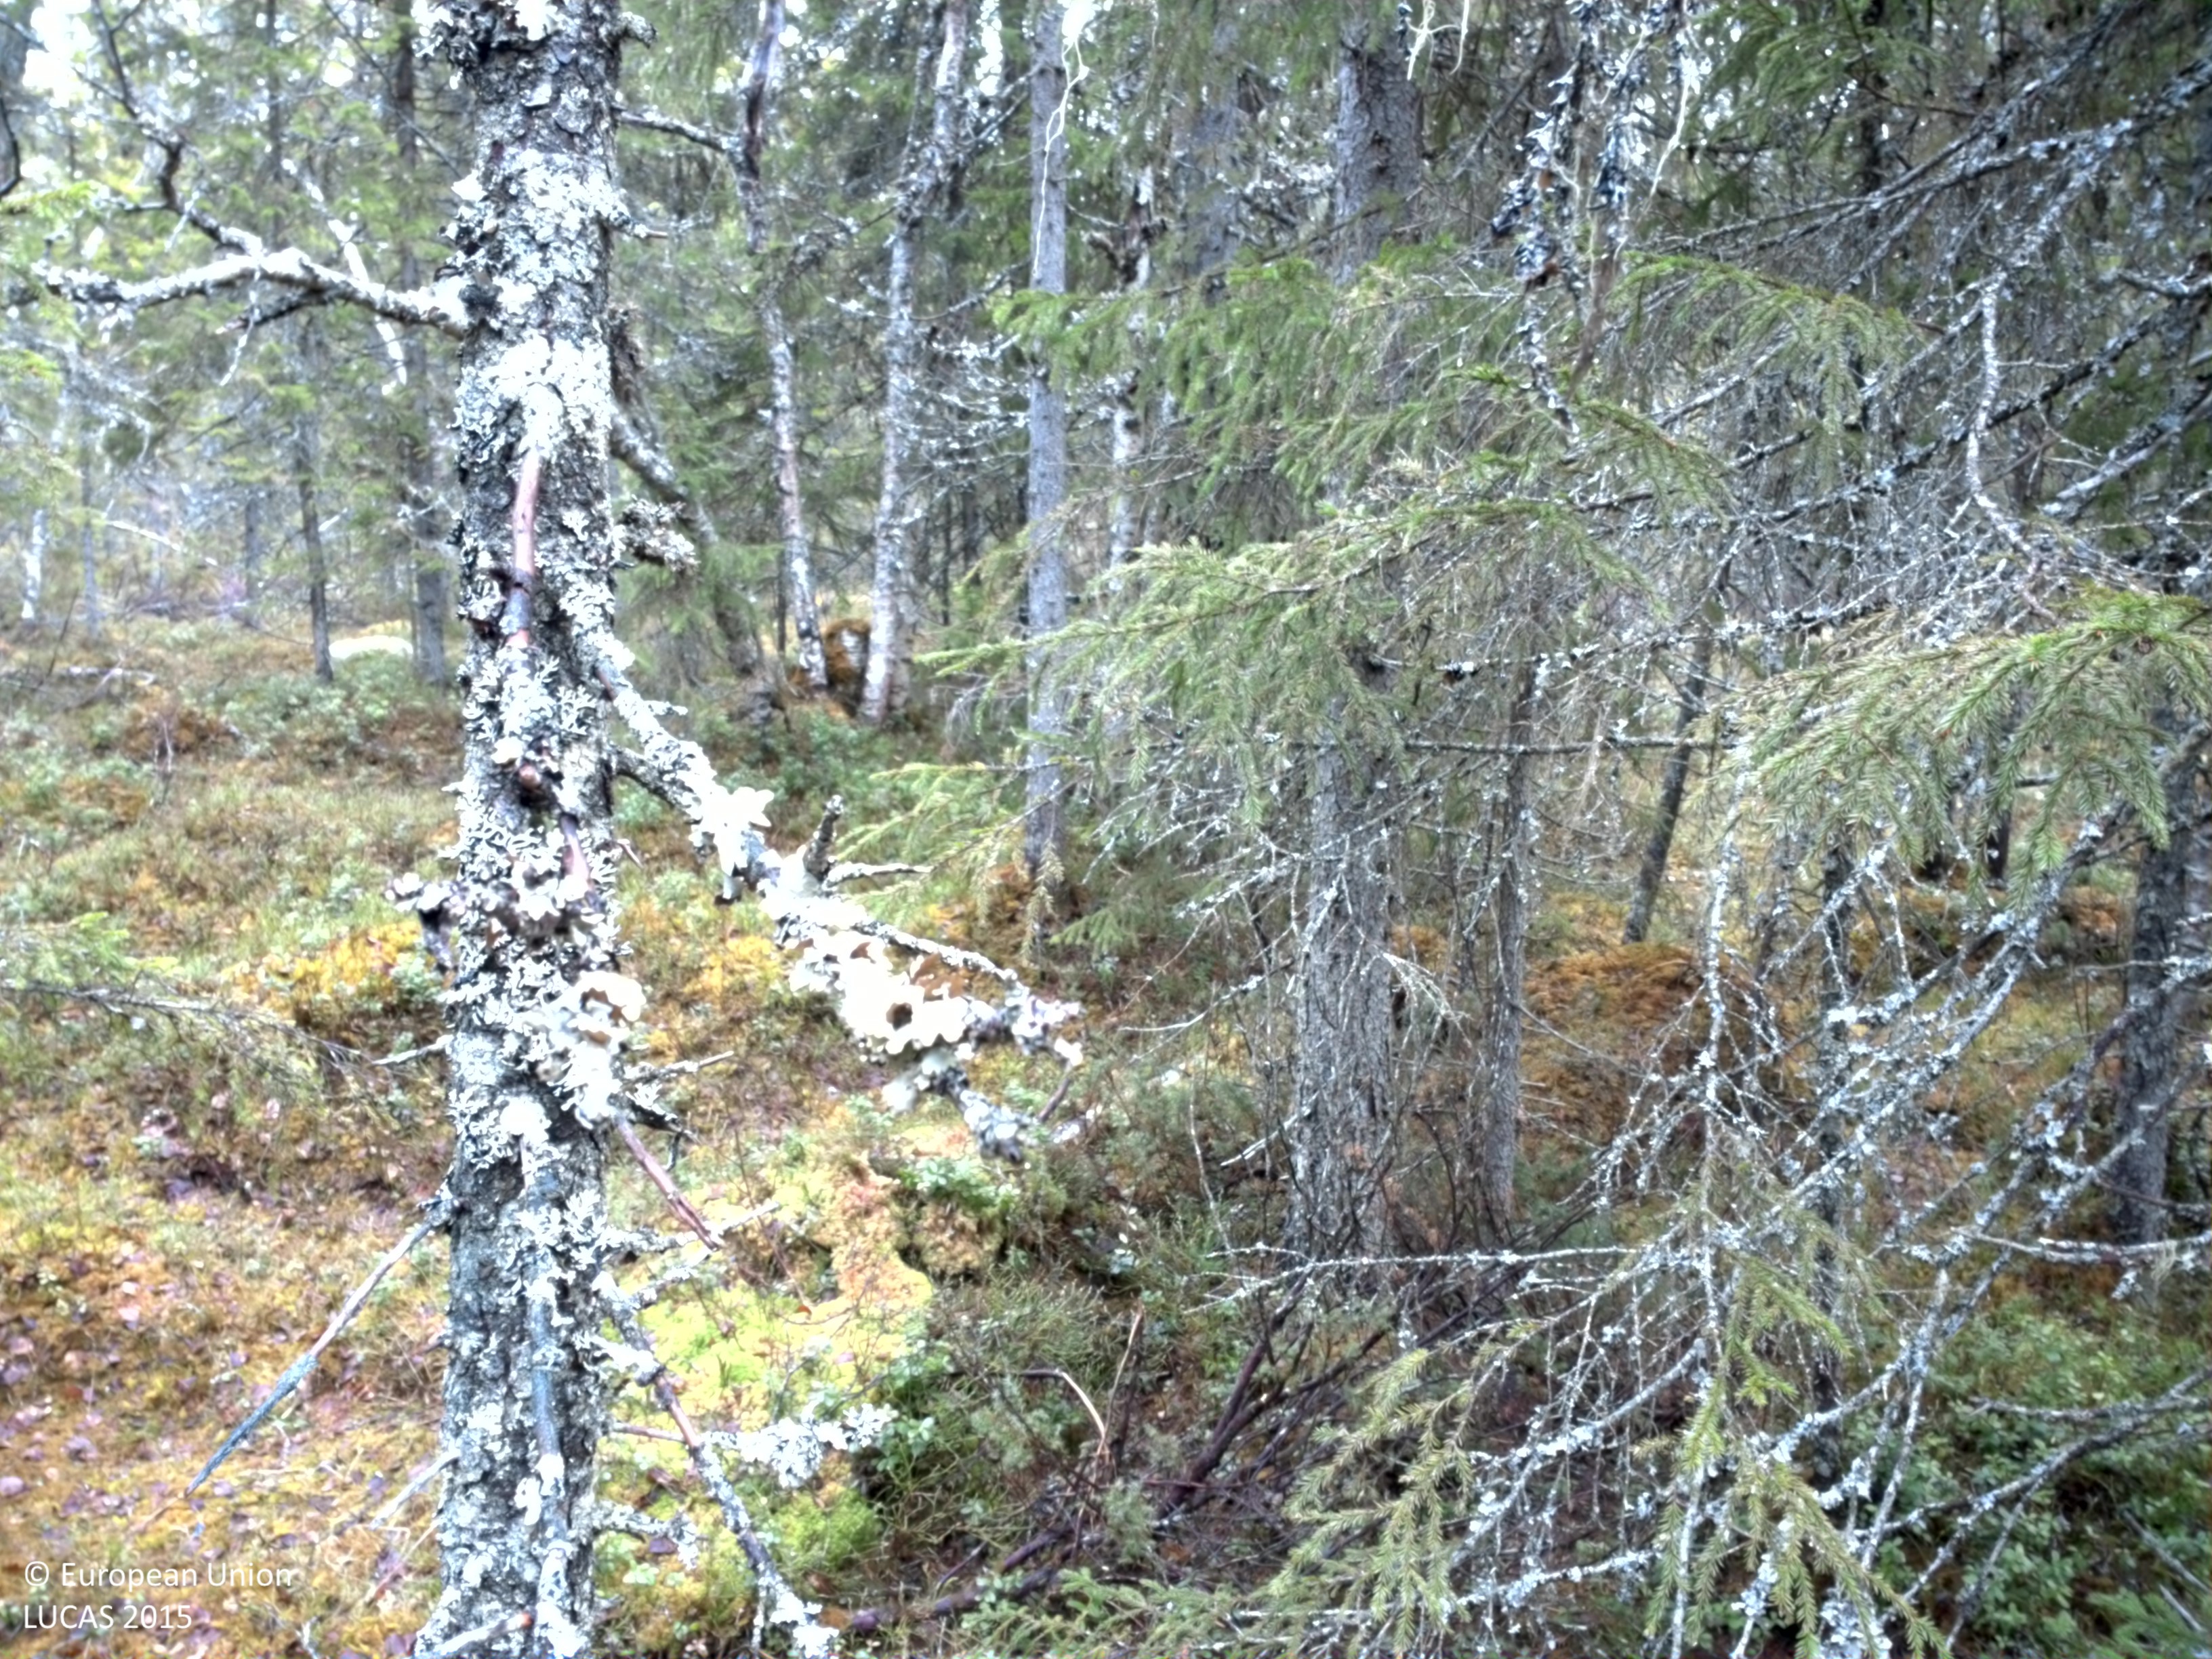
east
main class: Woodland
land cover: Spruce dominated coniferous woodland
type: boreal forest
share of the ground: > 75 %
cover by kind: coniferous forest trees 75 %, shrubs 20 %, broadleaved forest trees 5 %
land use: Forestry
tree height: > 5 m
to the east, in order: Spruce dominated coniferous woodland; Tracks; Spruce dominated coniferous woodland; Spruce dominated mixed woodland
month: May
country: SE
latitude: 63.4478
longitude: 13.8503
